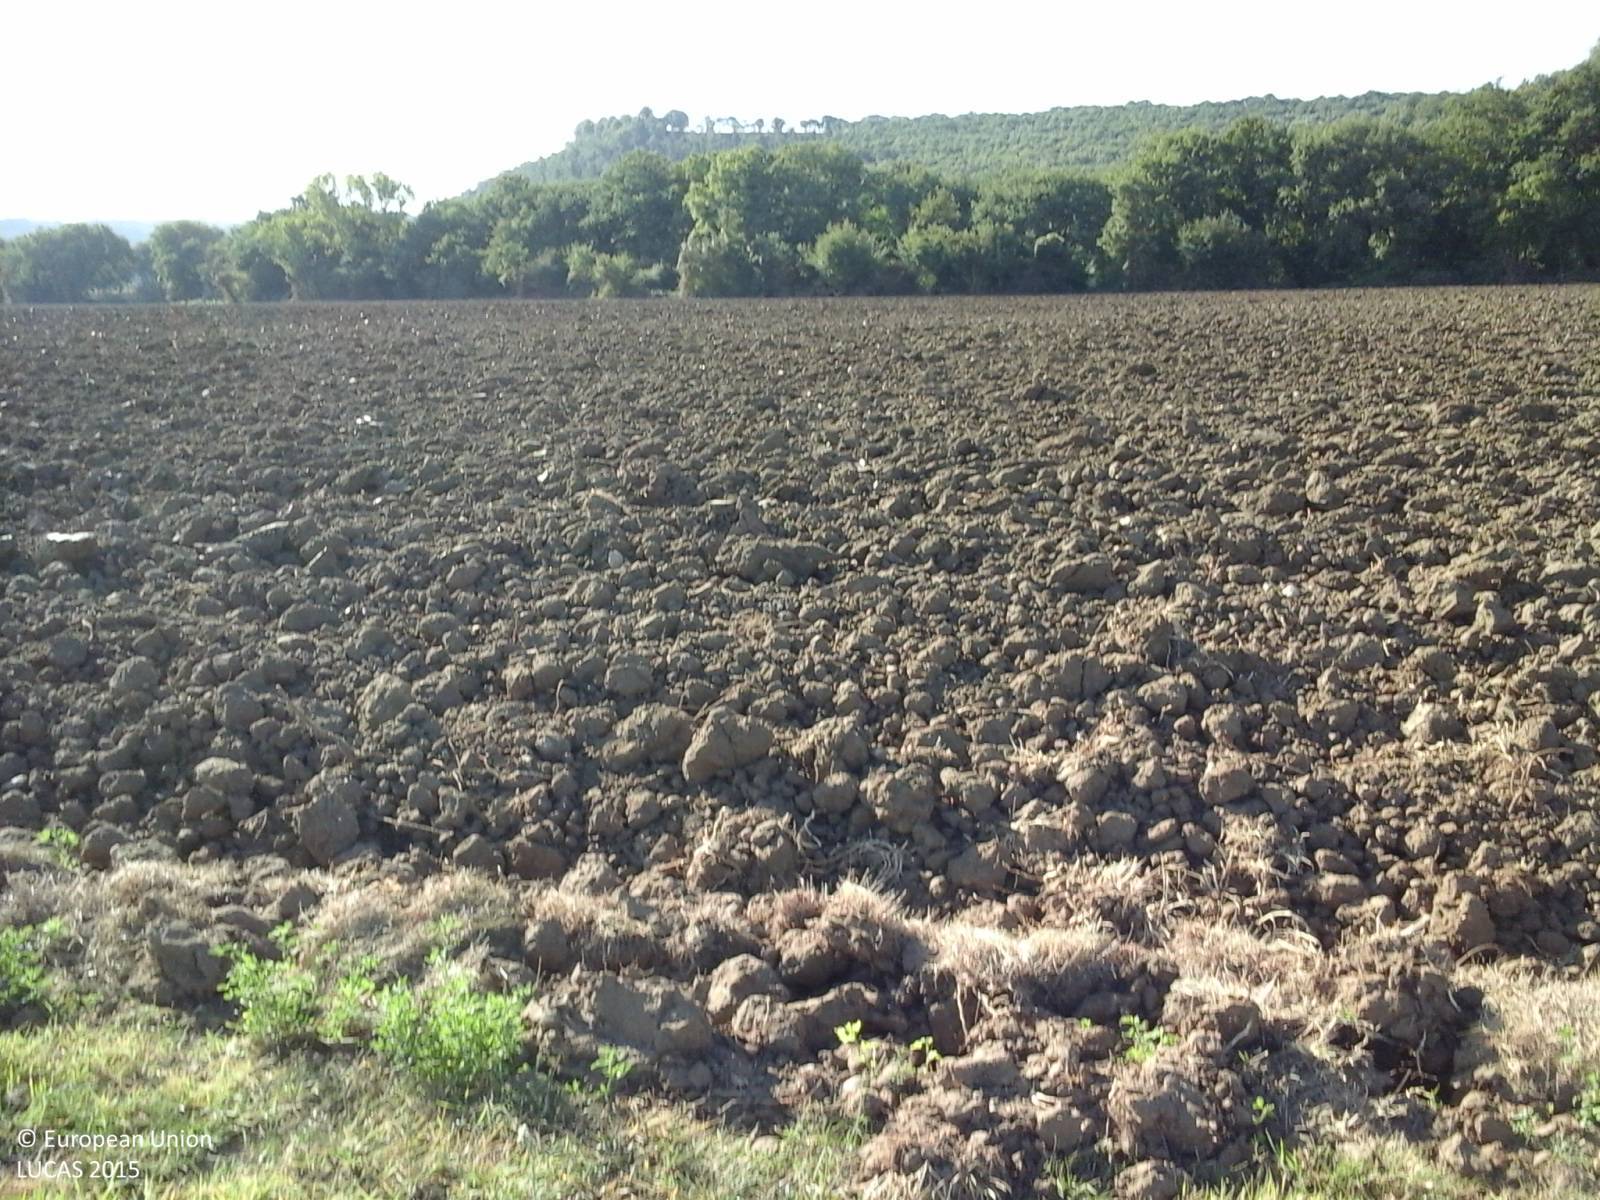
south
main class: Cropland
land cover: Lucerne
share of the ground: > 75 %
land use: Agriculture (excluding fallow land and kitchen gardens)
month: September
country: IT
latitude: 42.5388
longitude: 12.2451
